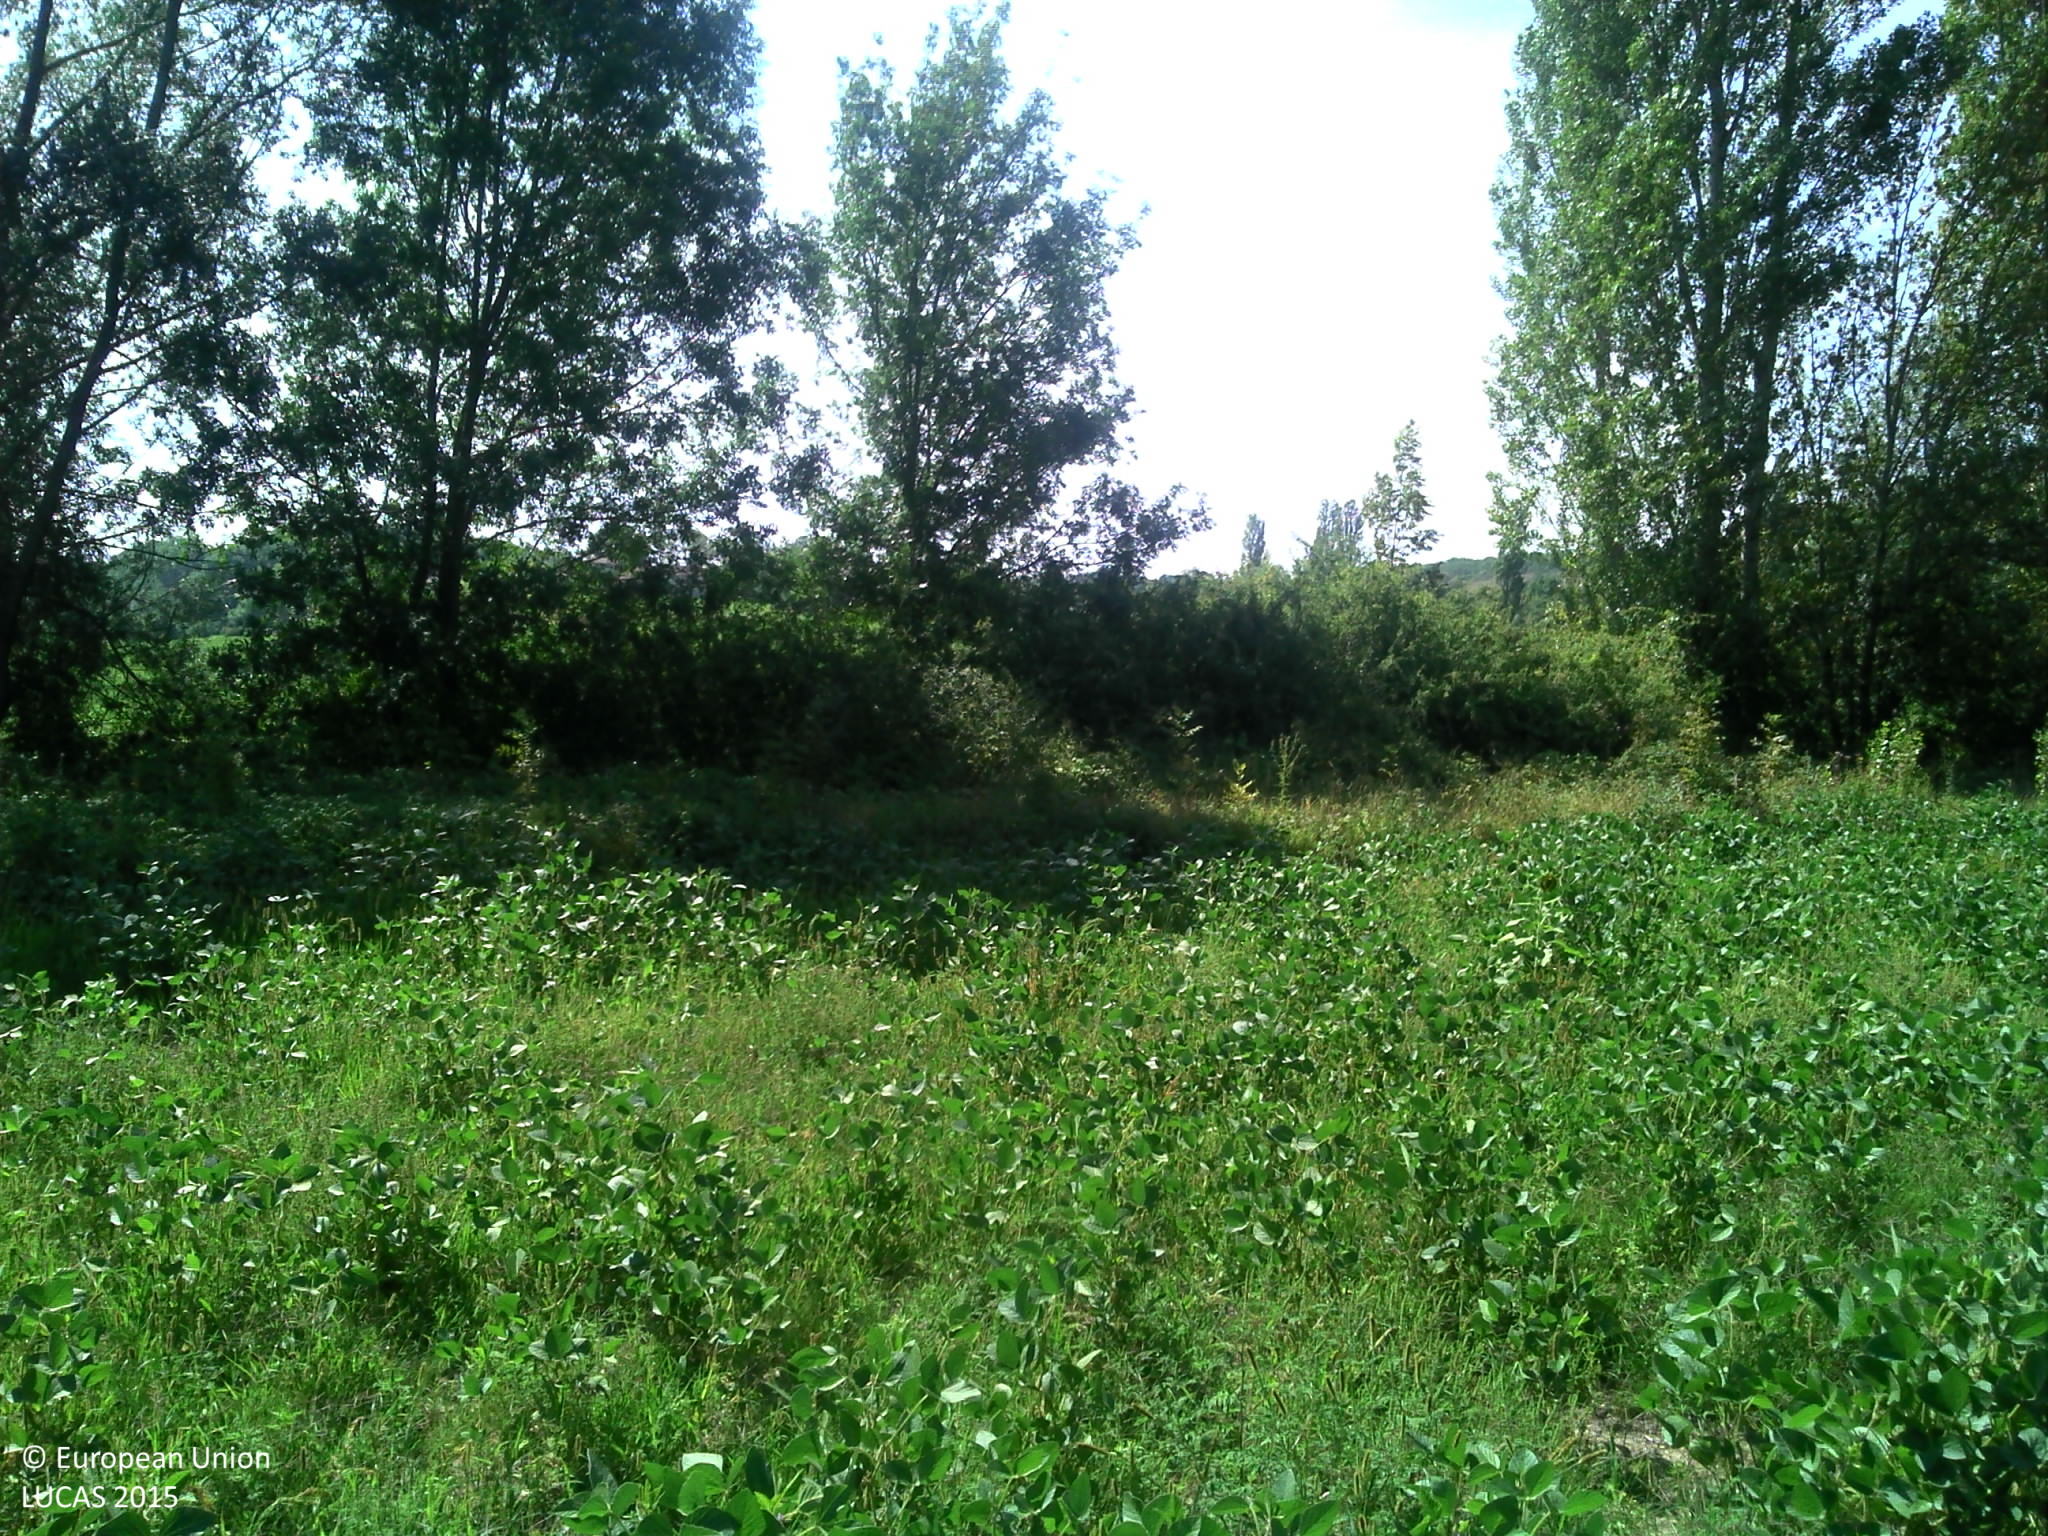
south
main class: Cropland
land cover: Soya
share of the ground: > 75 %
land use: Agriculture (excluding fallow land and kitchen gardens)
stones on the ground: < 10 %
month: August
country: FR
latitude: 44.3613
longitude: 1.2521
